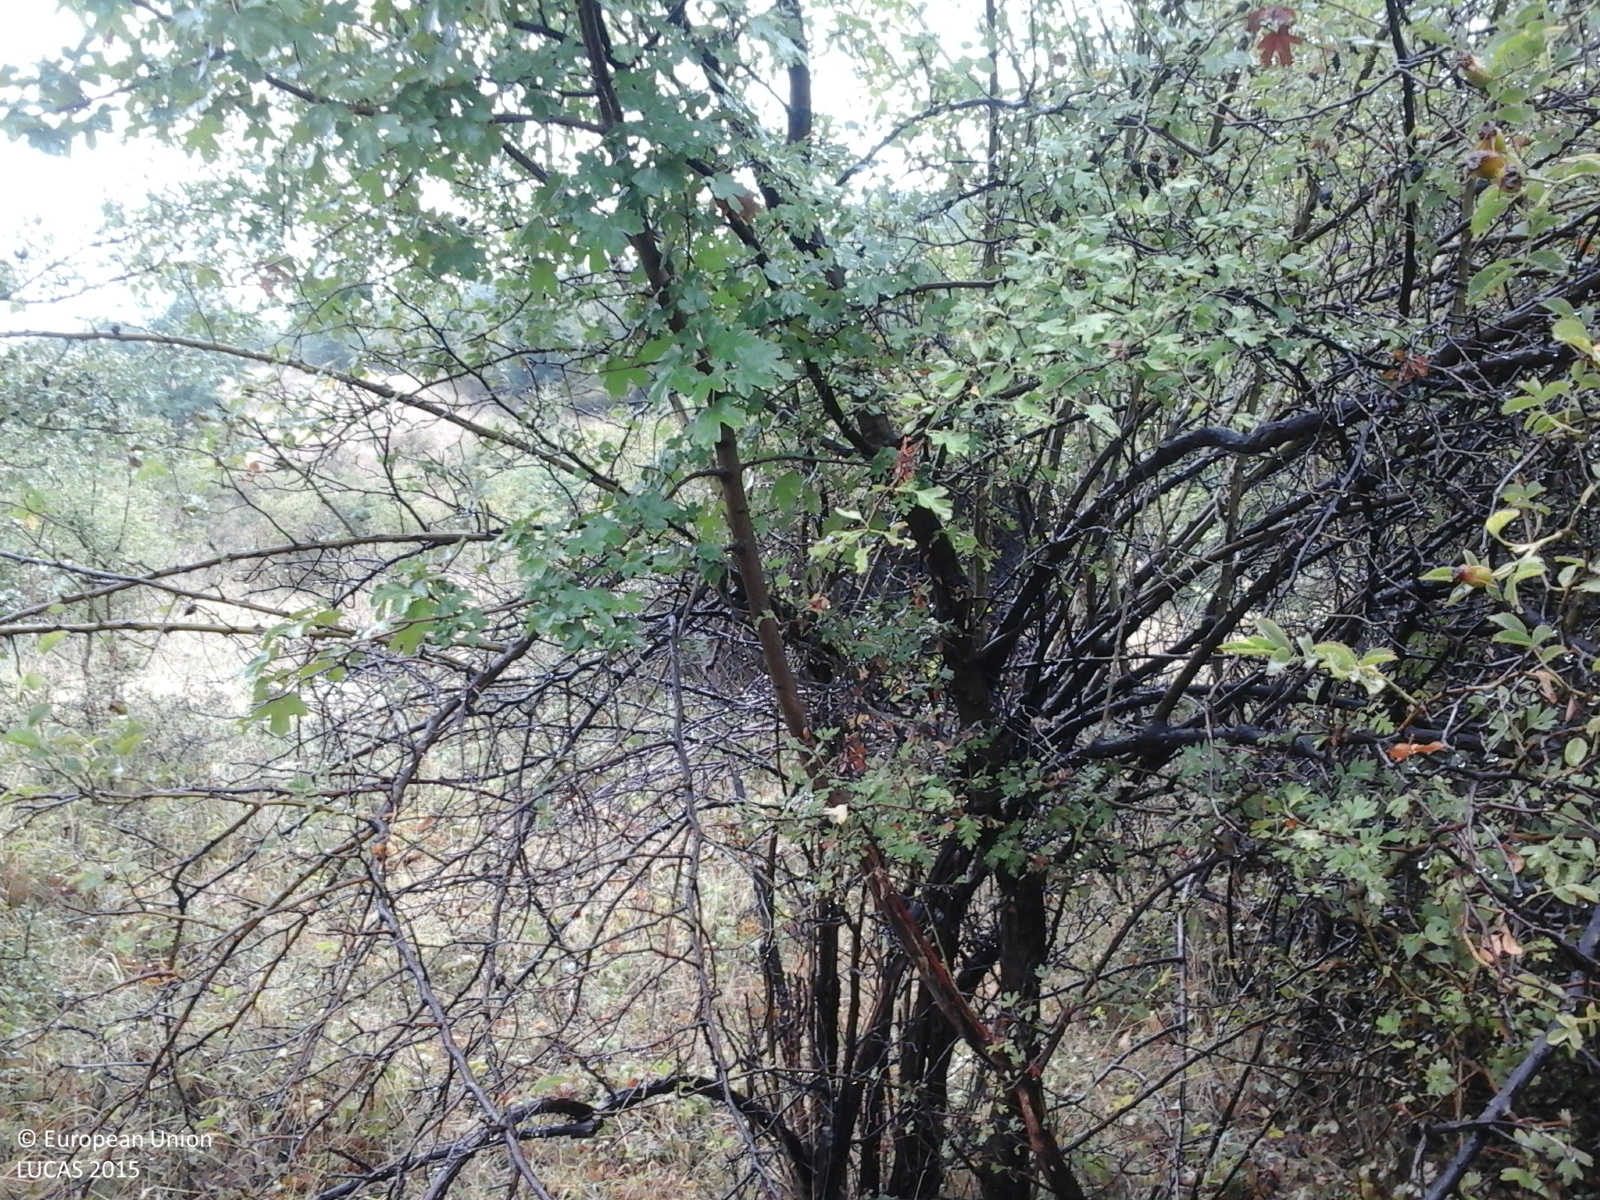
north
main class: Shrubland
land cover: Shrubland without tree cover
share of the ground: > 75 %
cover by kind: shrubs 100 %
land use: Semi-natural and natural areas not in use
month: August
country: RO
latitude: 44.5695
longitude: 22.8498
